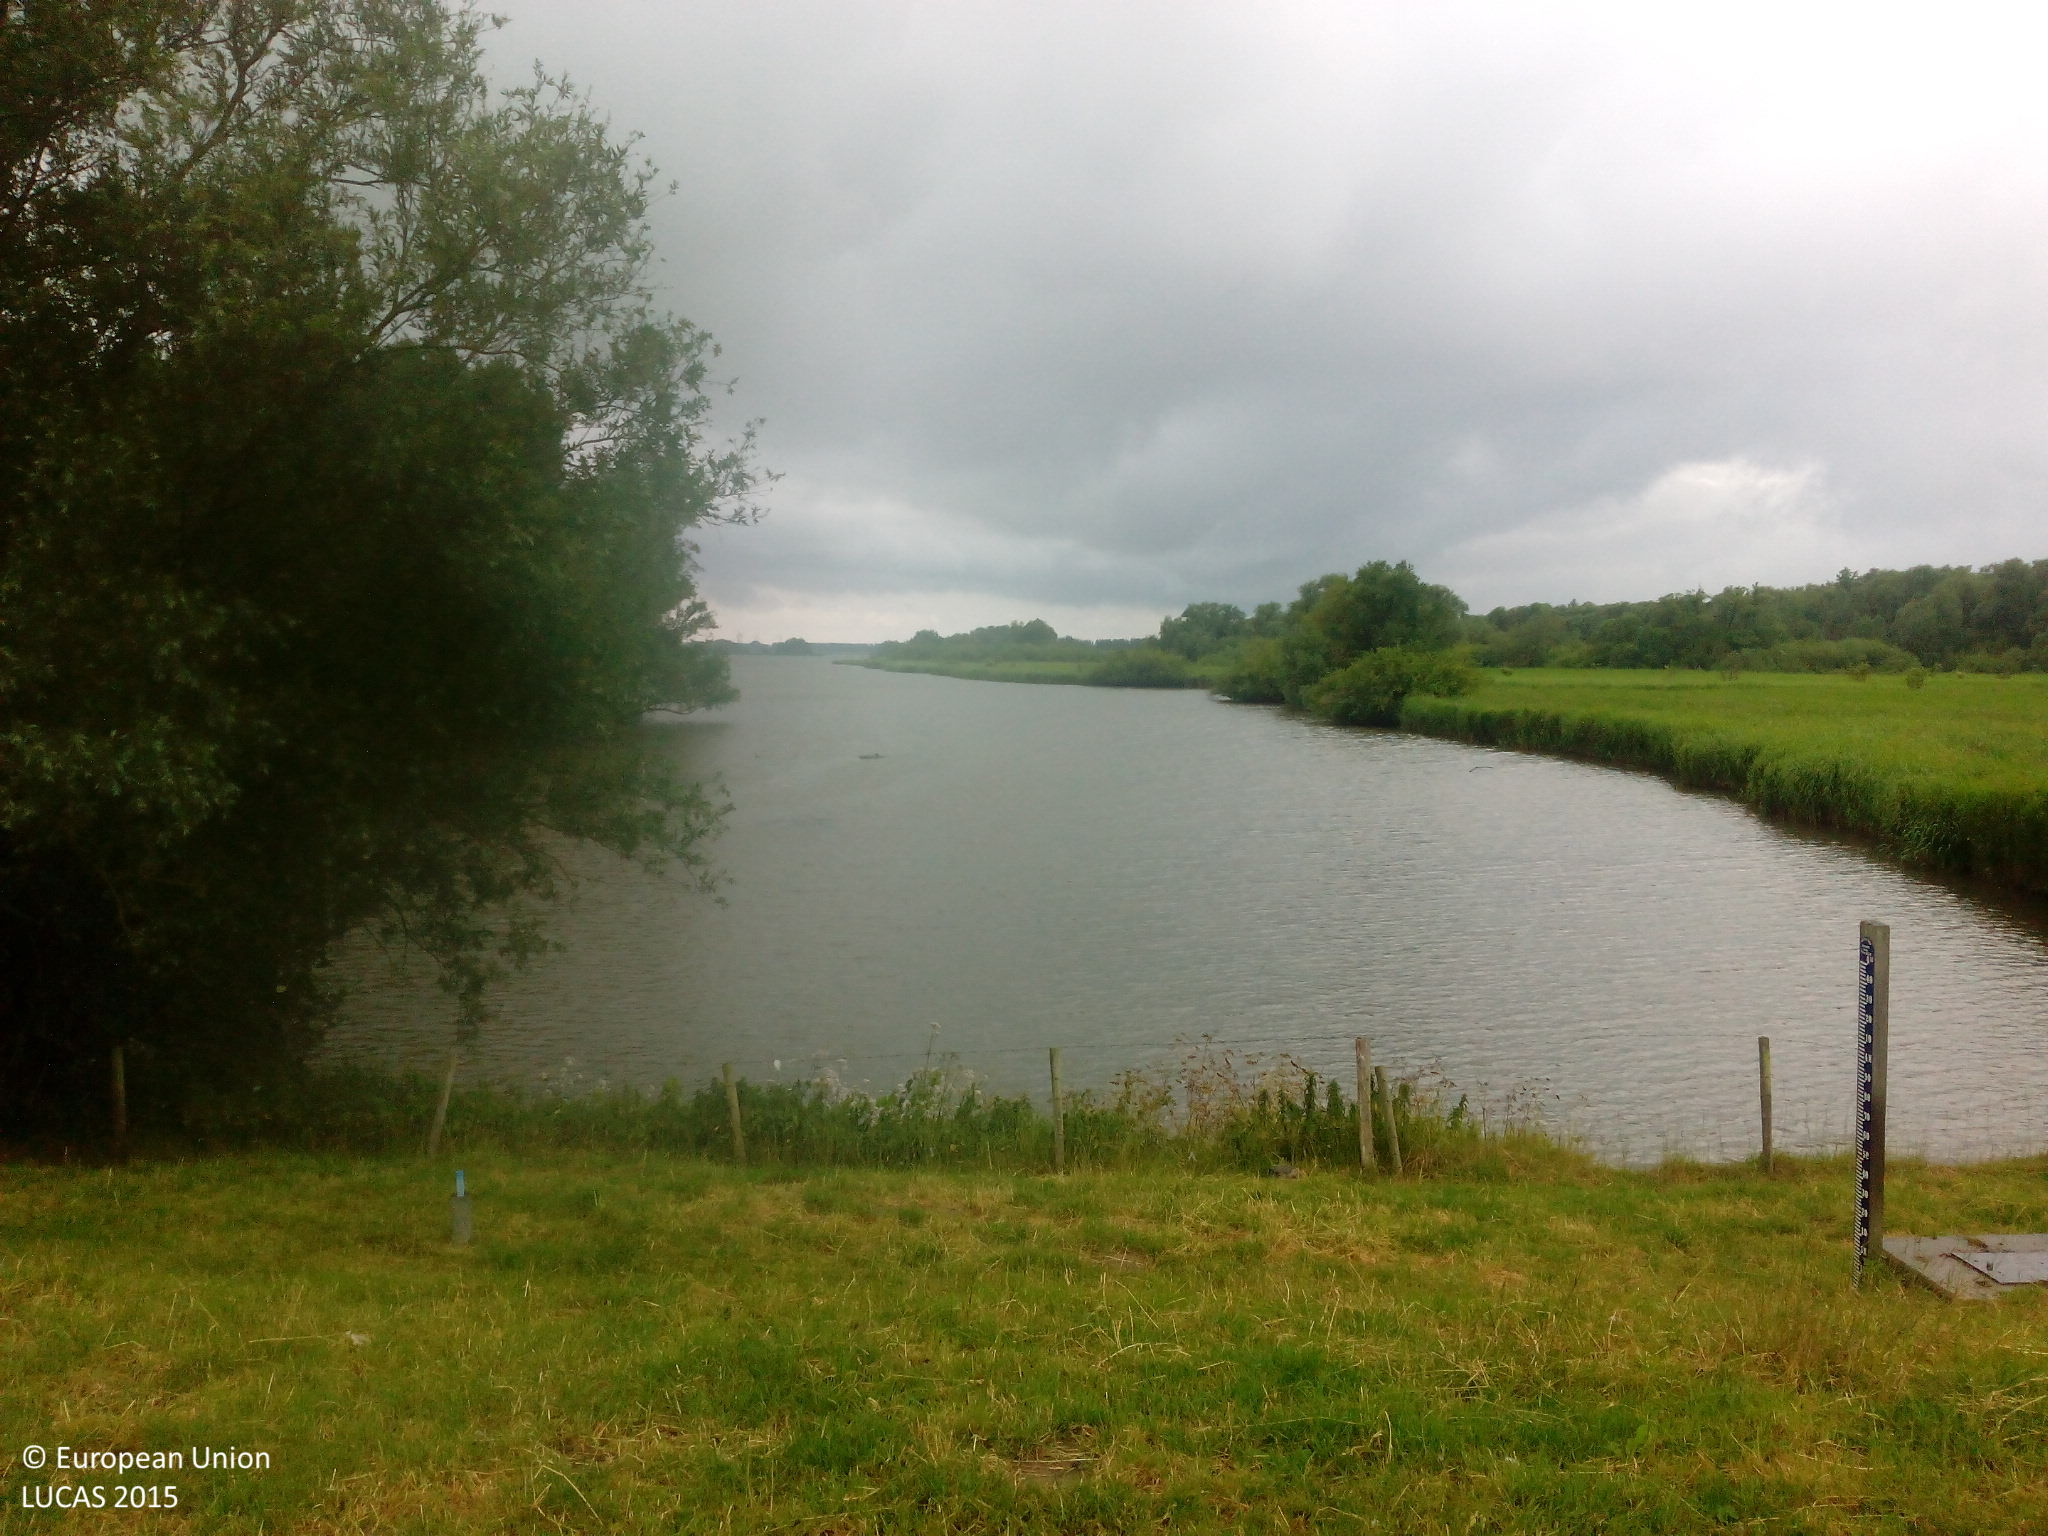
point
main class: Woodland
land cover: Broadleaved woodland
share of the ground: > 75 %
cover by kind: broadleaved forest trees 90 %, herbaceous plants 10 %
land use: Semi-natural and natural areas not in use
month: June
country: NL
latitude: 51.7538
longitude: 4.6799
